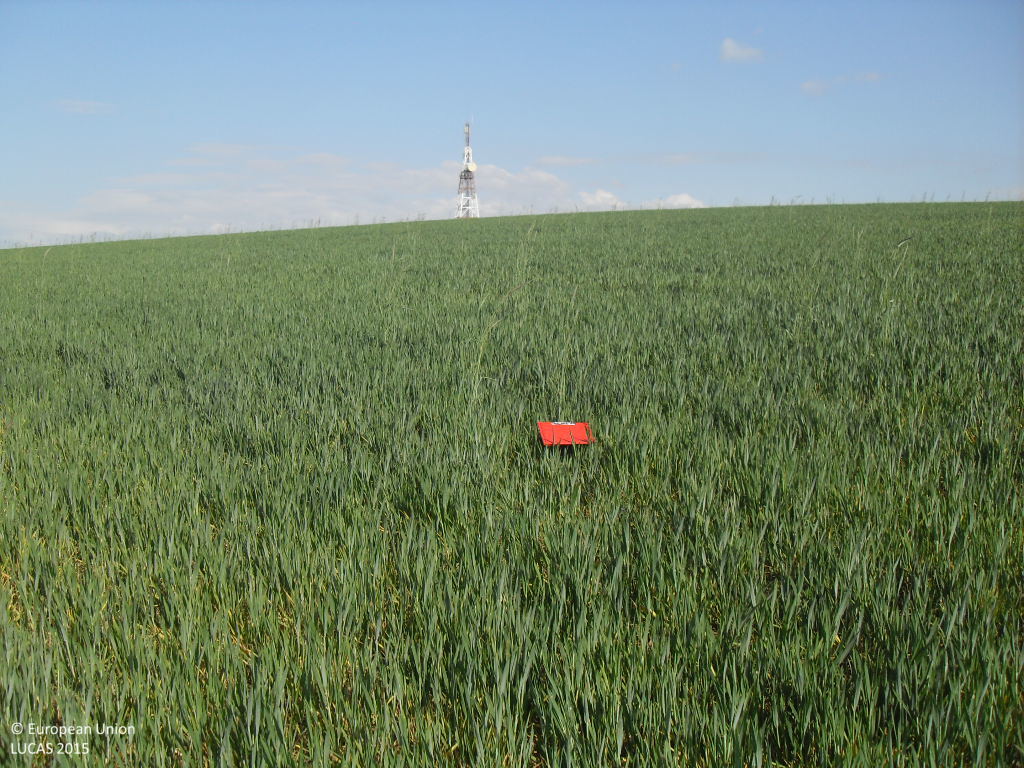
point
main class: Cropland
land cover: Common wheat
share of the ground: > 75 %
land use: Agriculture (excluding fallow land and kitchen gardens)
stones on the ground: < 10 %
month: April
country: ES
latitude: 40.8081
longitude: -5.2766
